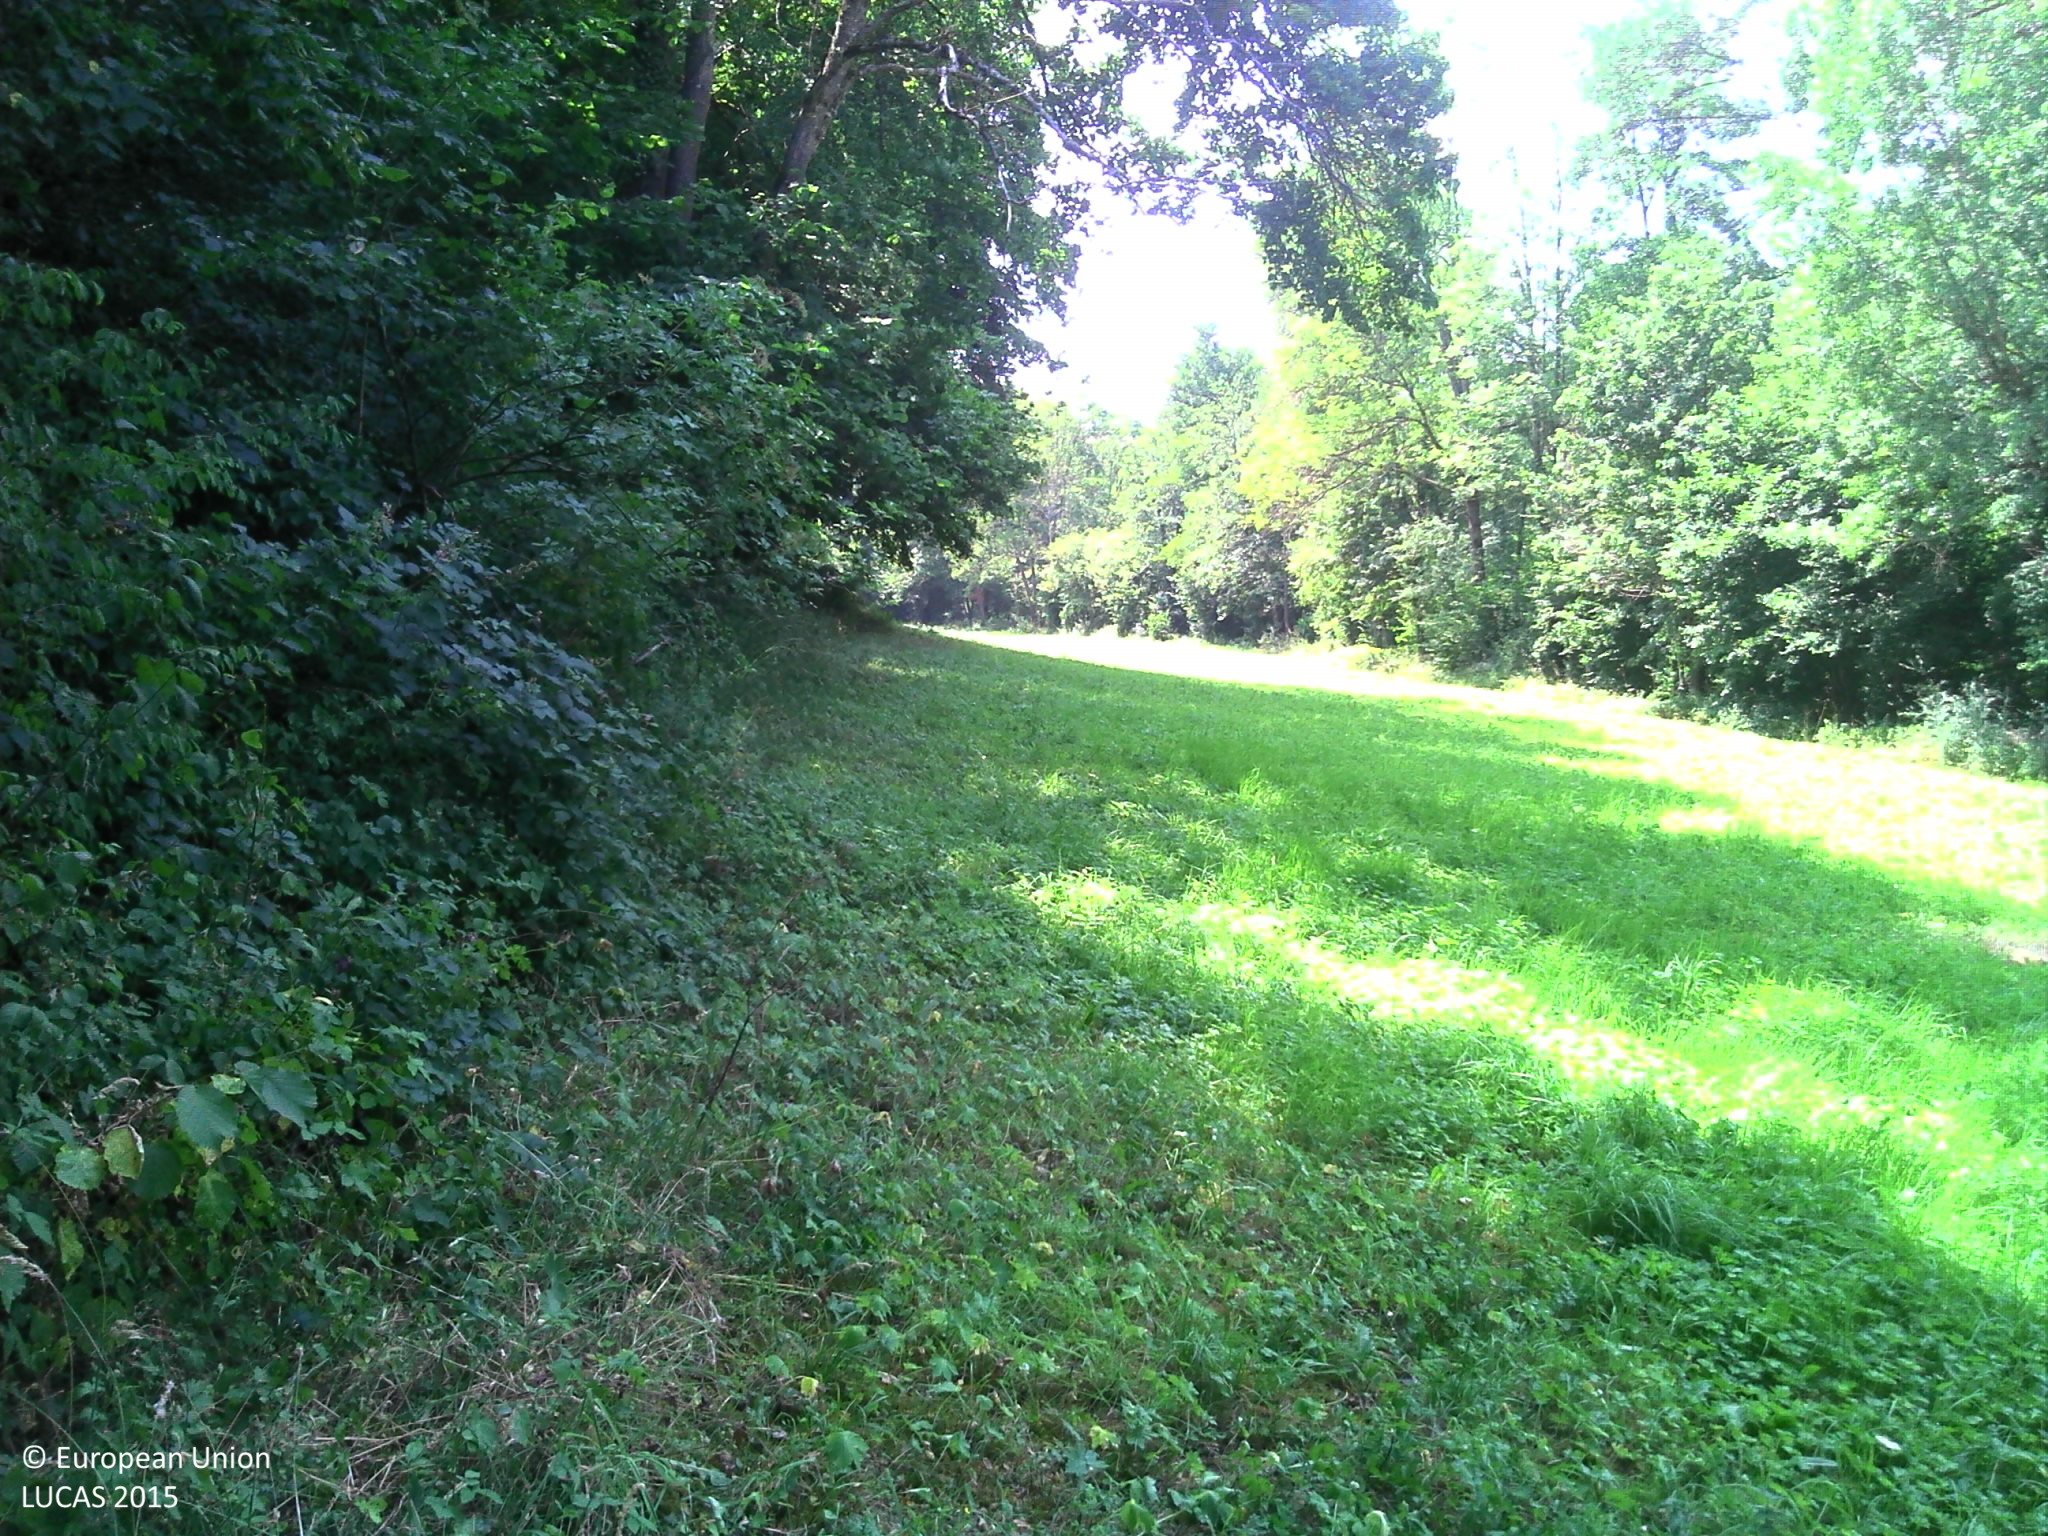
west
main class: Woodland
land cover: Broadleaved woodland
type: mesophytic deciduous forest
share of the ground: > 75 %
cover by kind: broadleaved forest trees 100 %
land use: Forestry
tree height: > 5 m
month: July
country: FR
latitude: 45.2855
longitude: 3.2063
